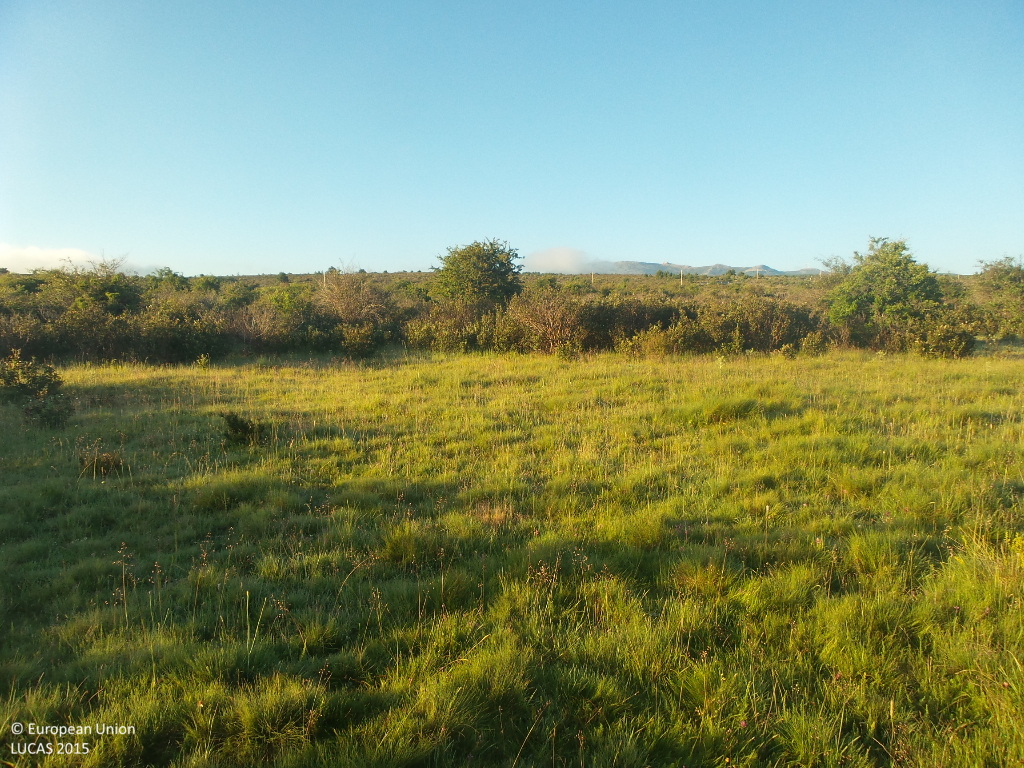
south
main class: Shrubland
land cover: Shrubland without tree cover
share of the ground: 50 - 75 %
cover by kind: shrubs 55 %, herbaceous plants 45 %
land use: Semi-natural and natural areas not in use
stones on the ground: < 10 %
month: June
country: ES
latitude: 41.2205
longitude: -3.0528
